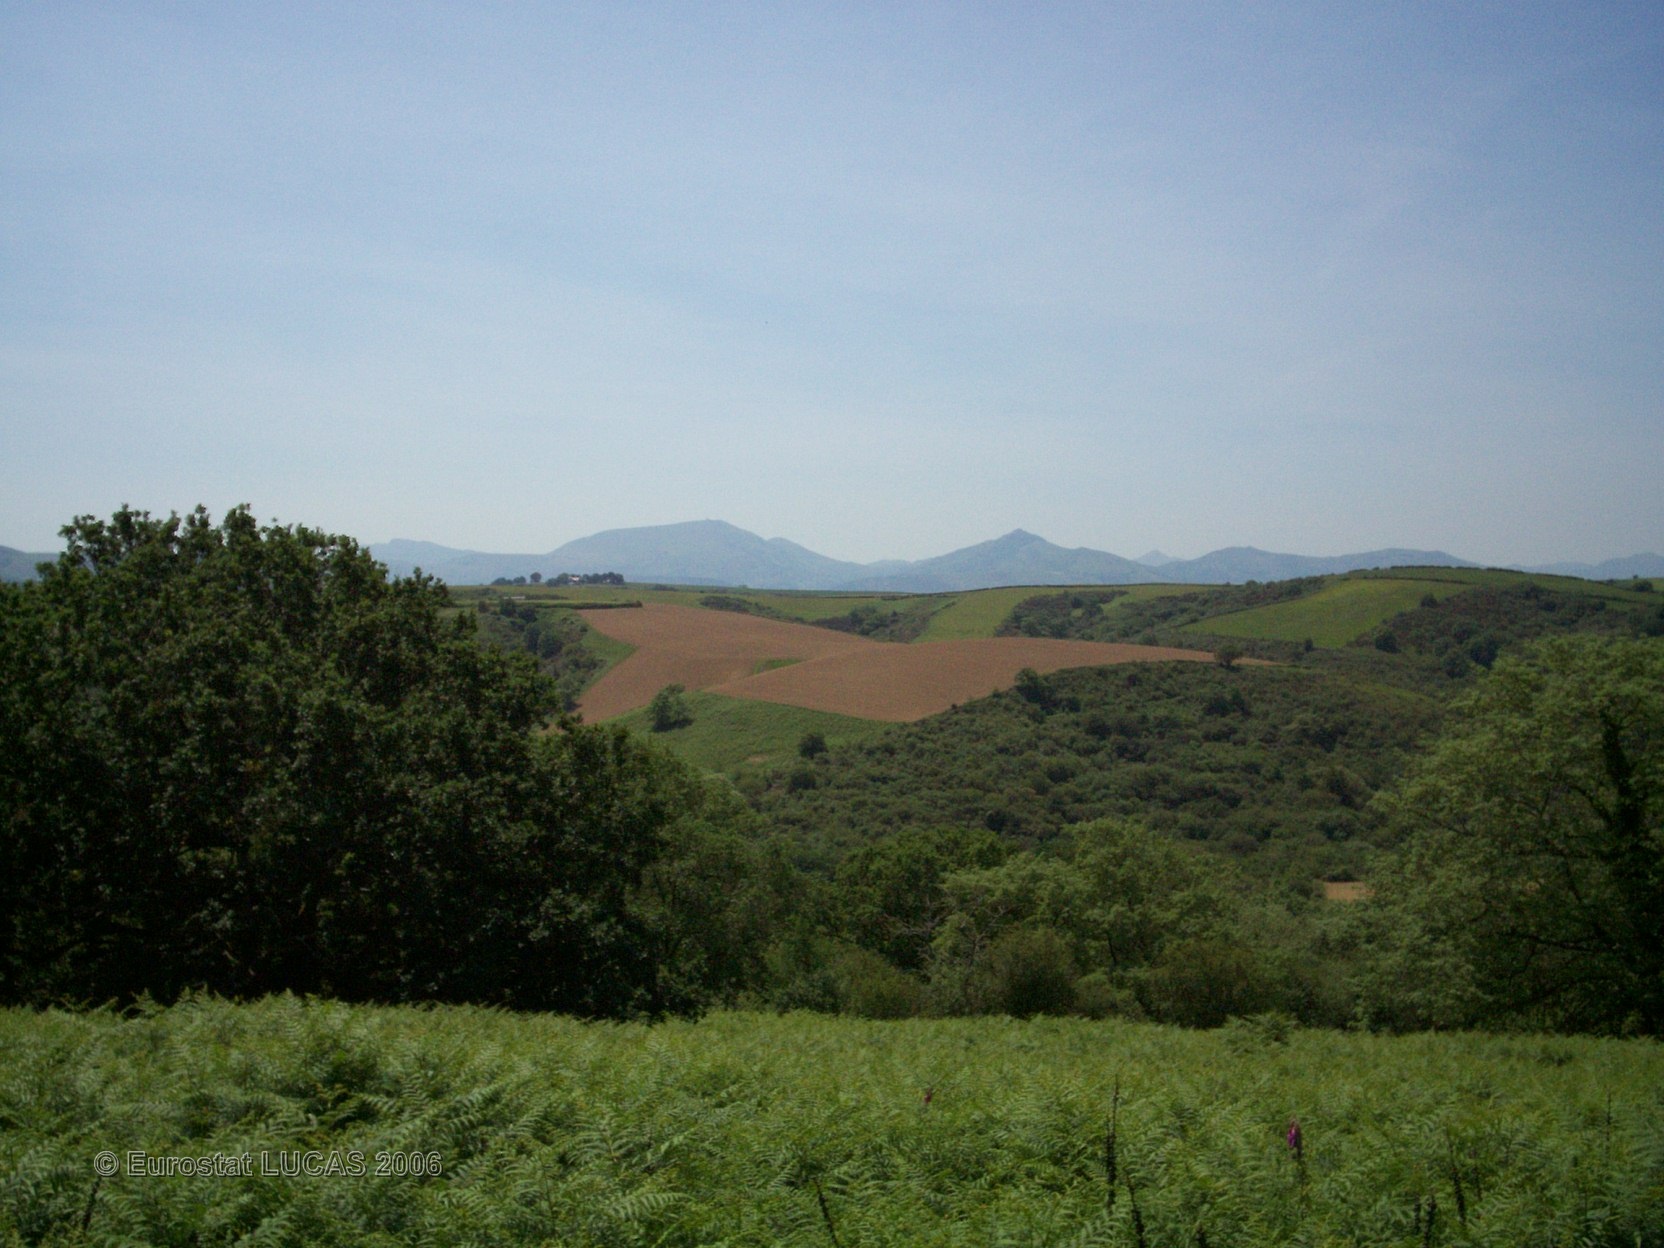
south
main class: Grassland
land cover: Grassland without tree/shrub cover
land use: Agriculture (excluding fallow land and kitchen gardens)
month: May
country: FR
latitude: 43.4145
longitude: -1.3663
